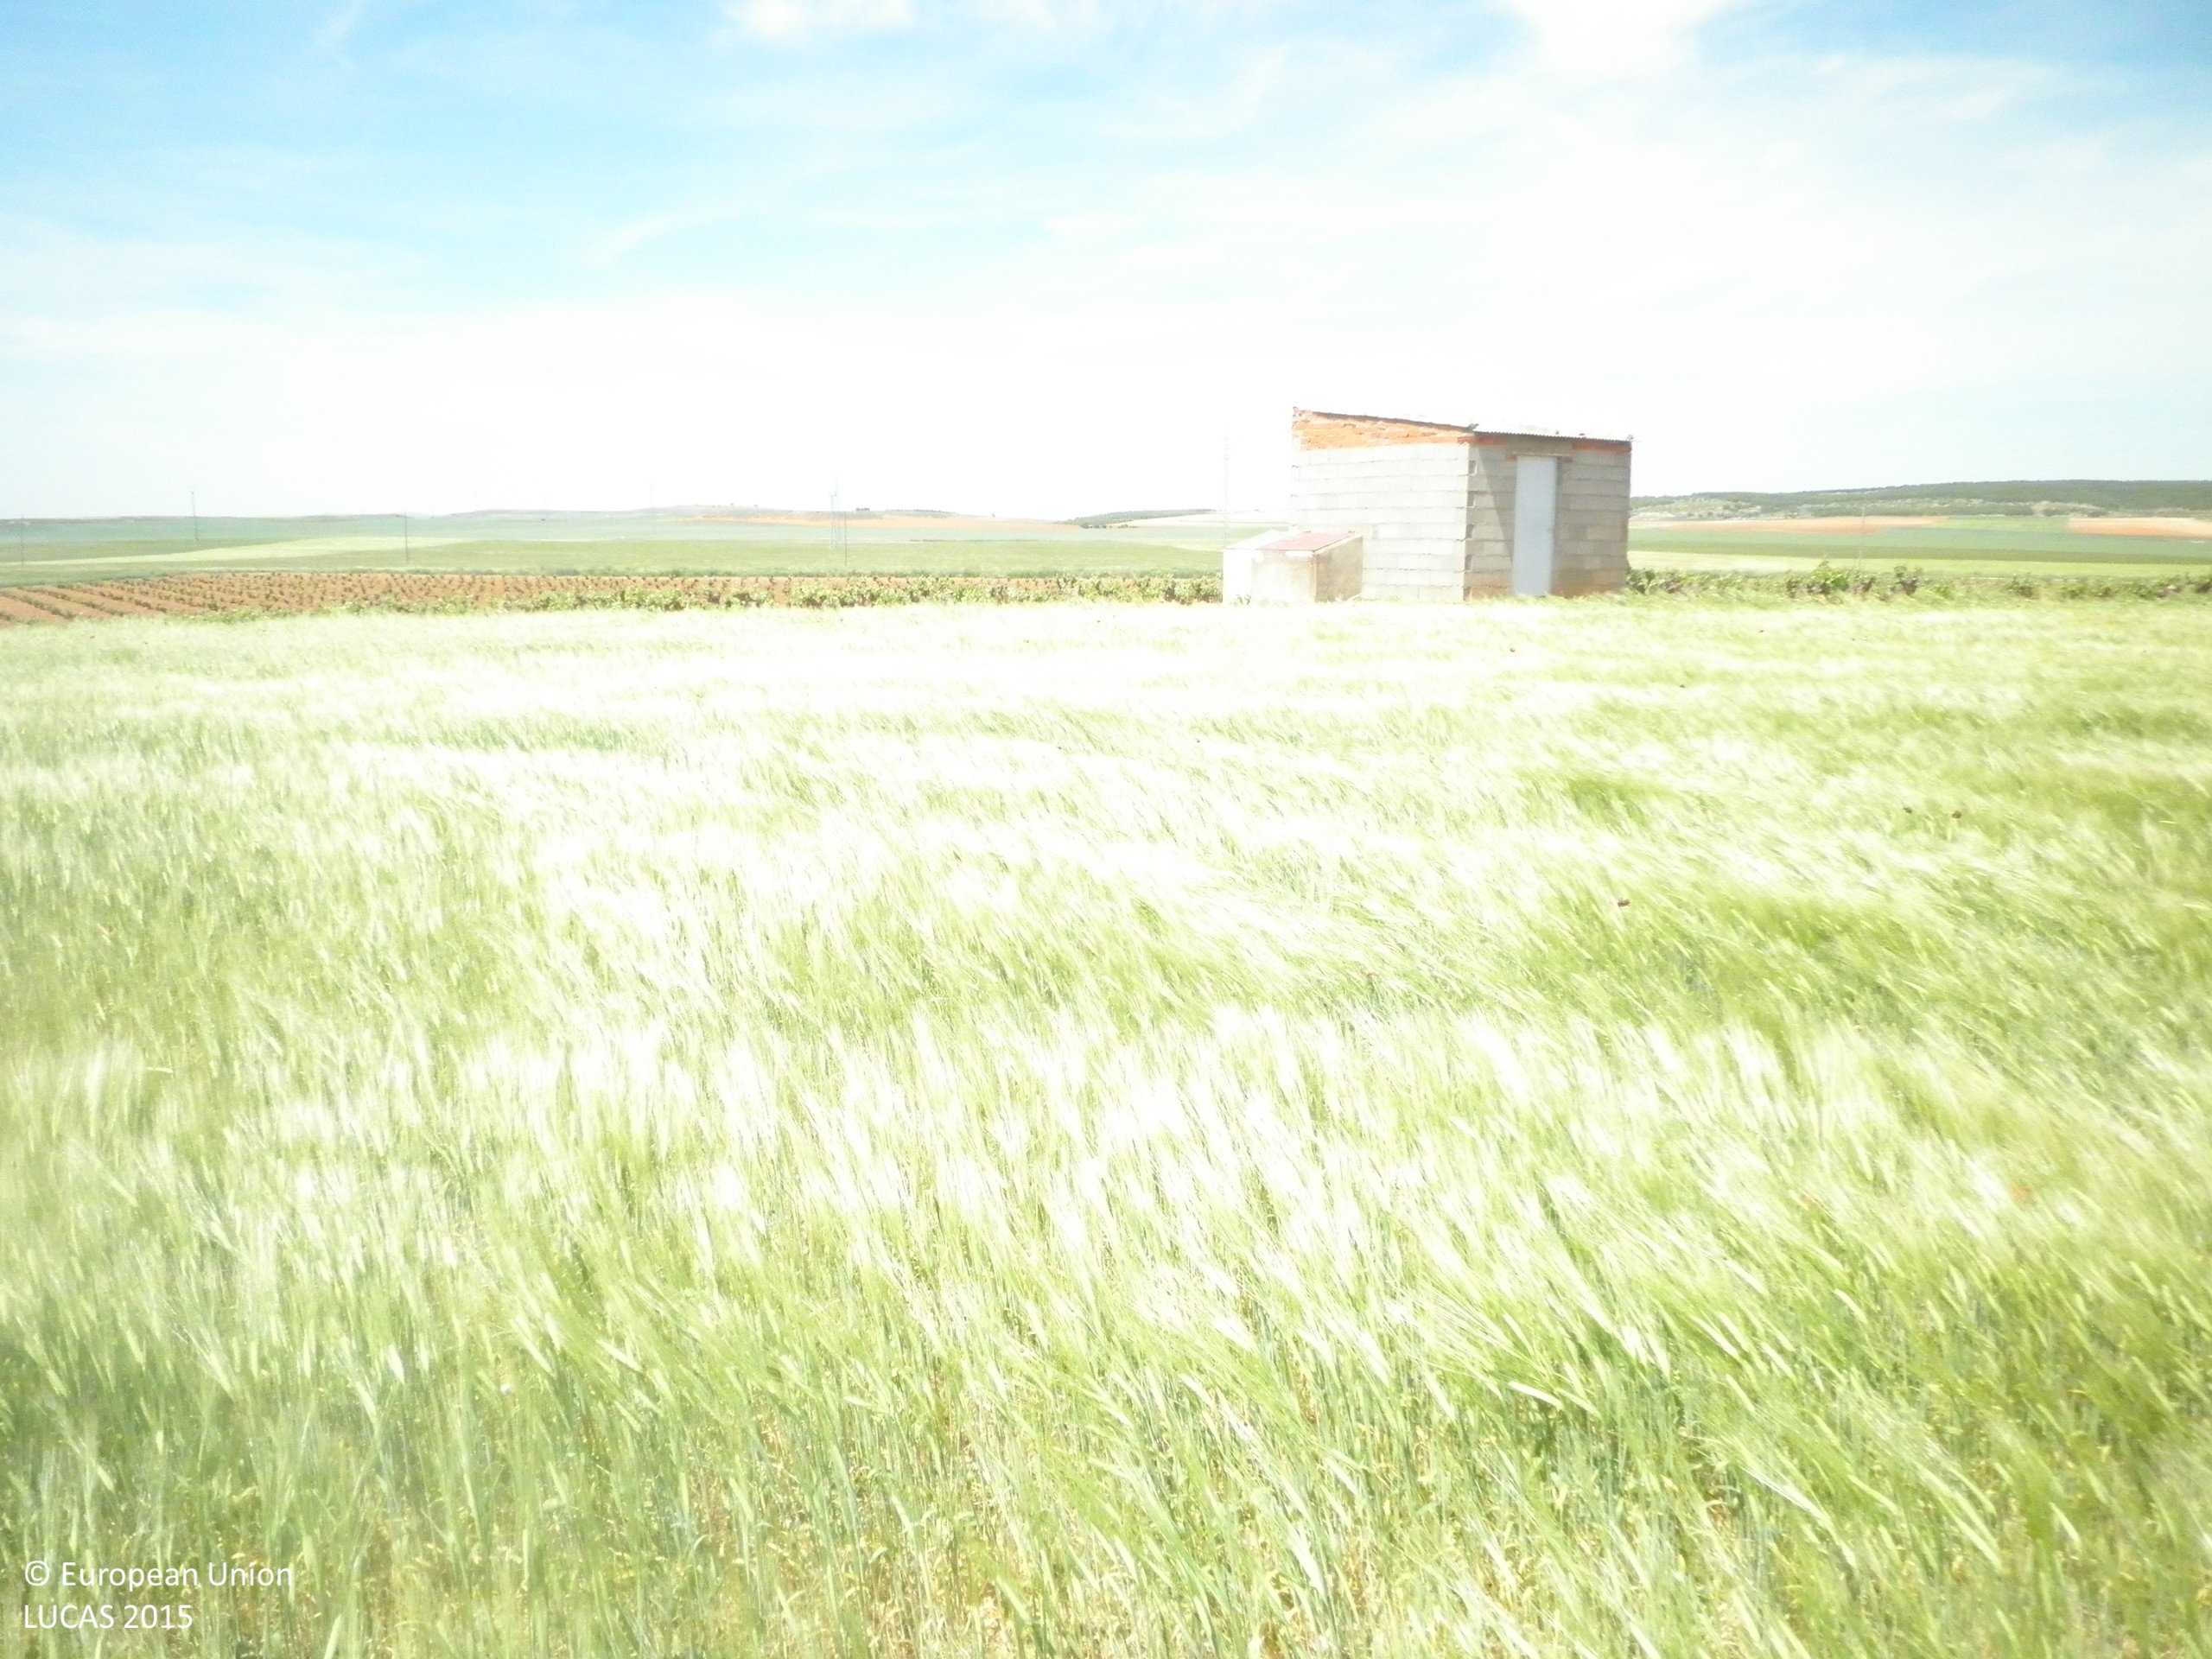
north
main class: Cropland
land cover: Barley
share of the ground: > 75 %
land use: Agriculture (excluding fallow land and kitchen gardens)
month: May
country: ES
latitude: 39.5616
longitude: -2.7368
